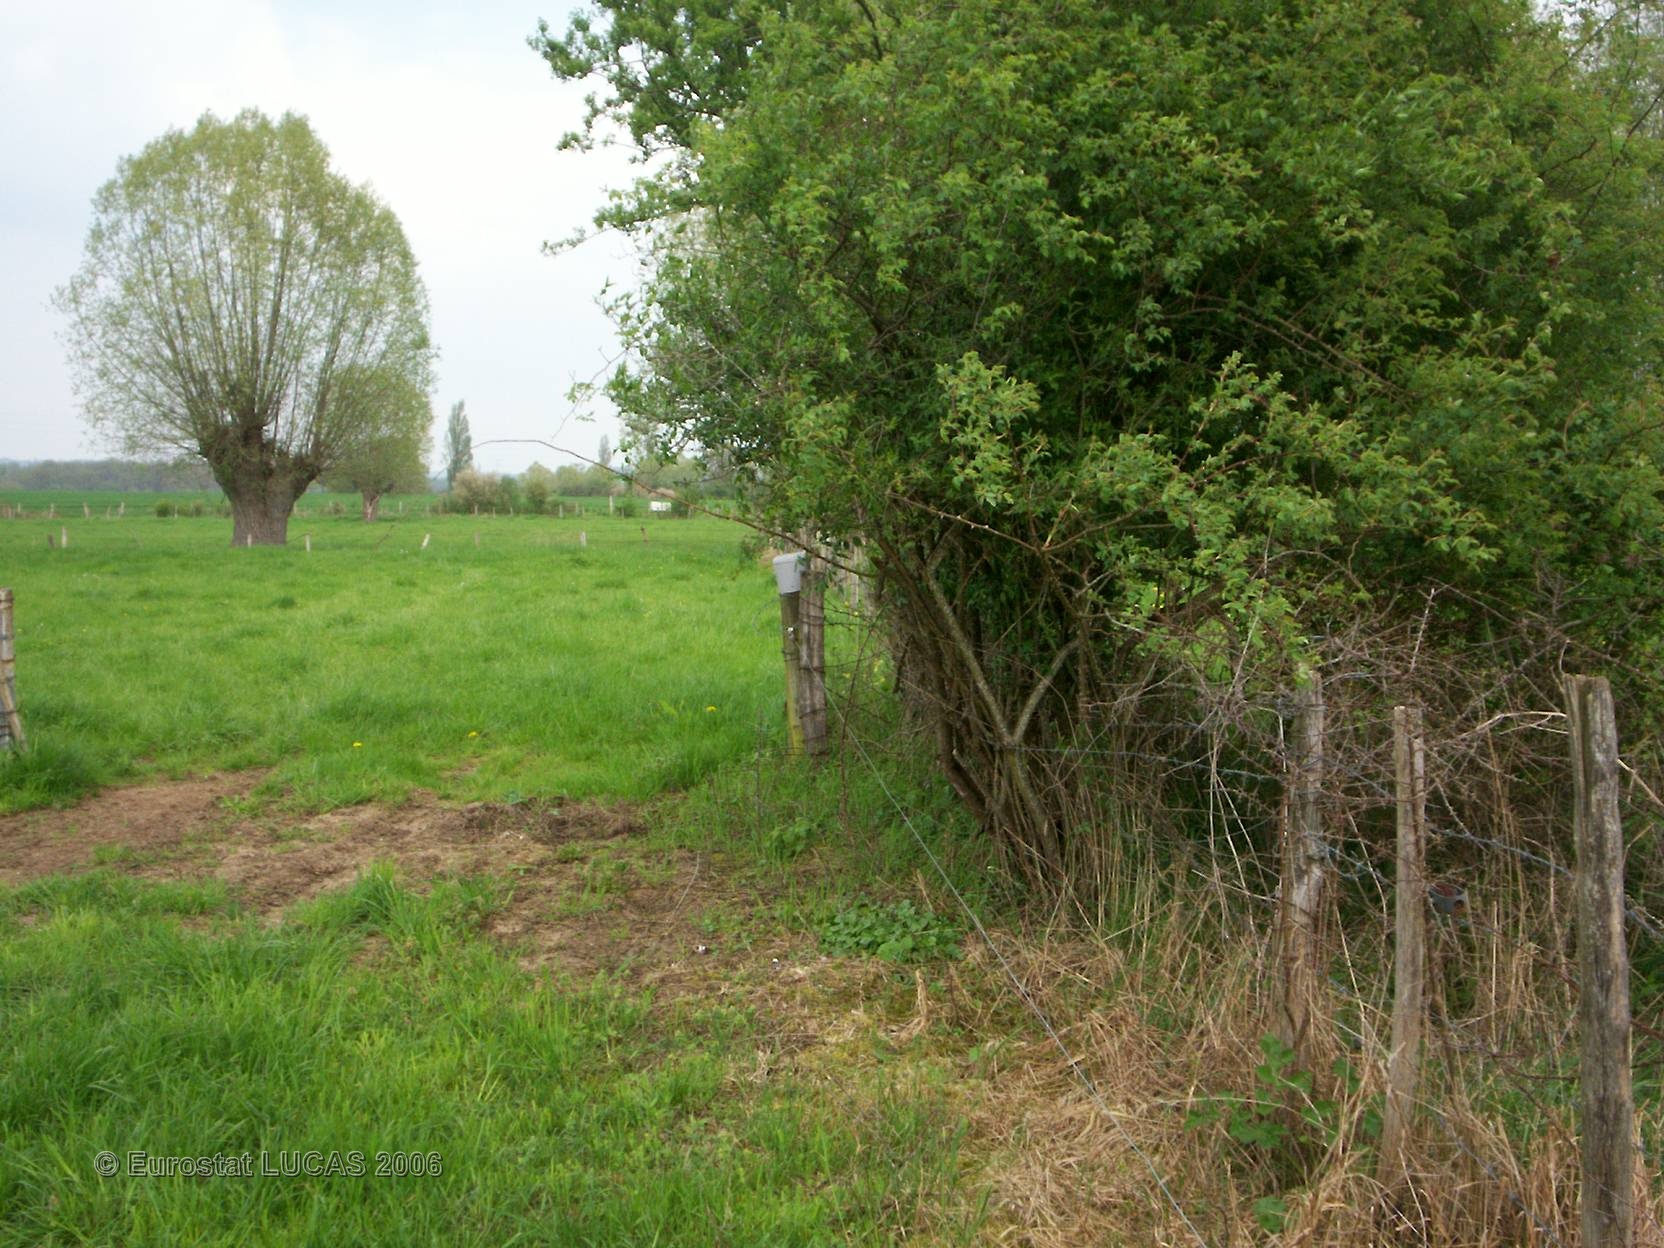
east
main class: Grassland
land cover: Grassland with sparse tree/shrub cover
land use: Agriculture (excluding fallow land and kitchen gardens)
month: April
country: FR
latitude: 47.0831
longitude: 3.0542
